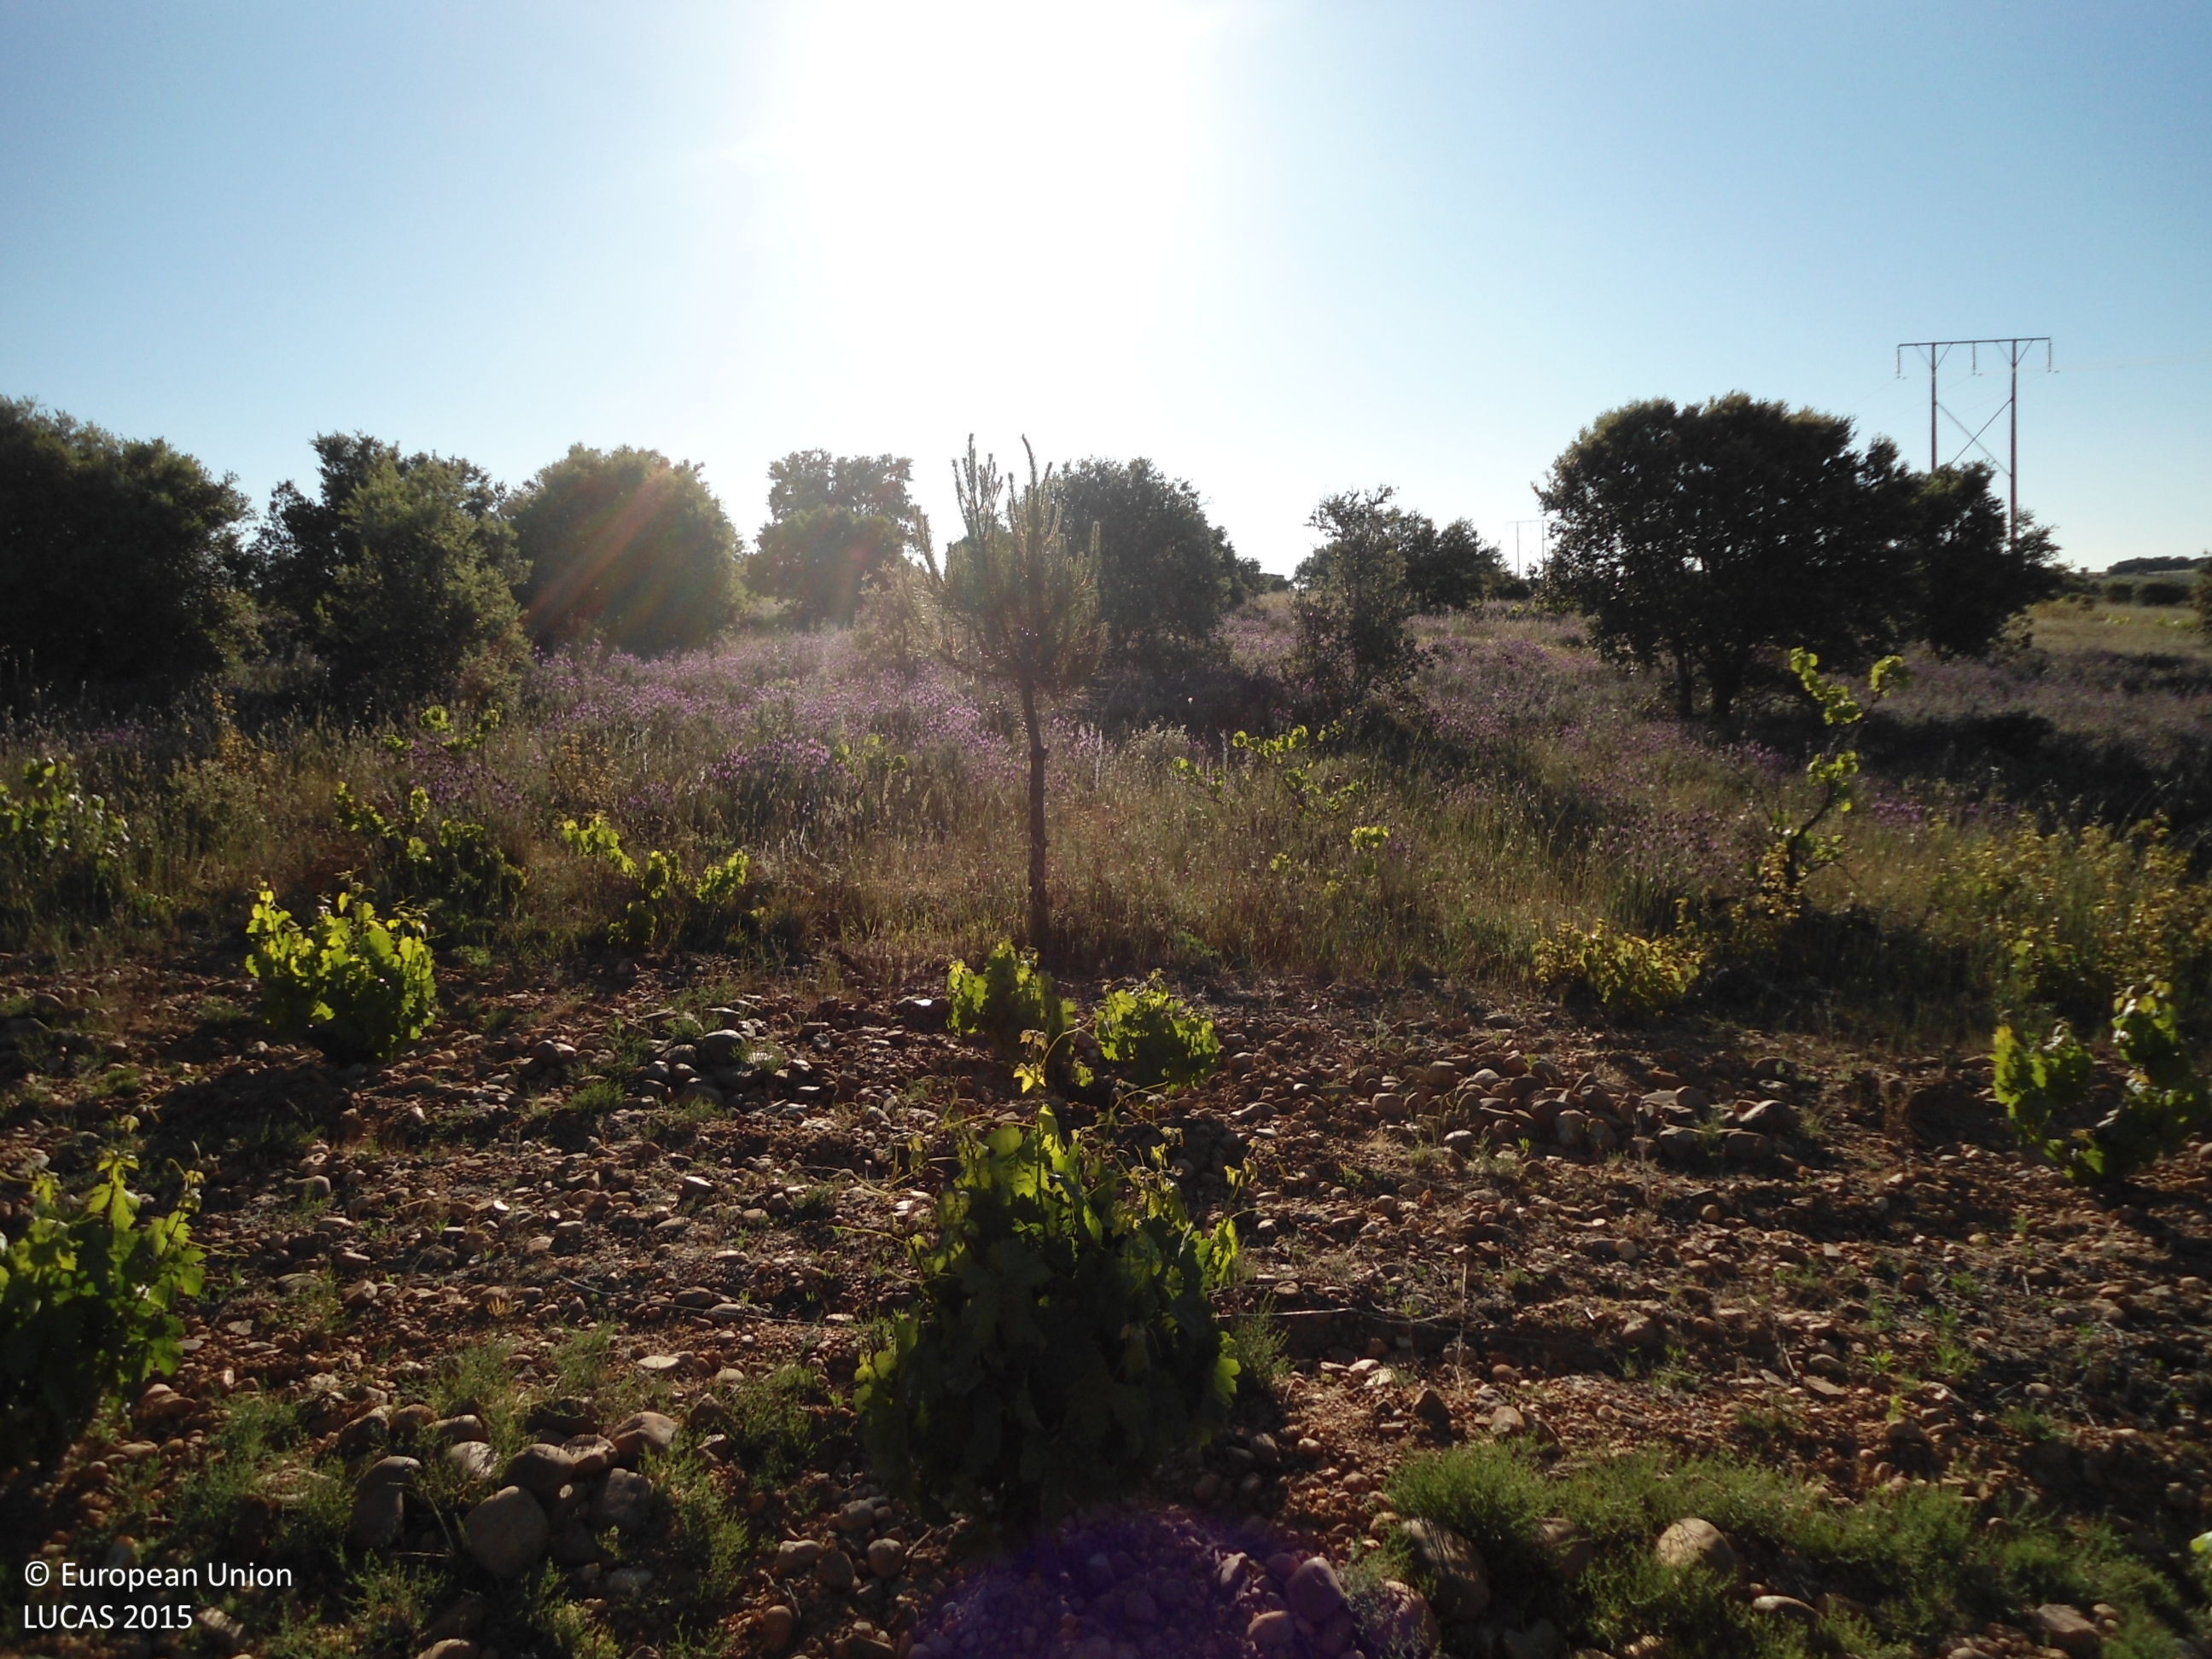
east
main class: Cropland
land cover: Vineyards
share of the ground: 25 - 50 %
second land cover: Other bare soil
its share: > 75 %
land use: Agriculture (excluding fallow land and kitchen gardens)
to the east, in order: Vineyards; Other bare soil; Shrubland with sparse tree cover; Grassland with sparse tree/shrub cover; Vineyards; Spontaneously vegetated surfaces; Vineyards; Abandoned hedges; Tracks; Broadleaved woodland; Vineyards
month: May
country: ES
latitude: 42.0090
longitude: -5.9268
